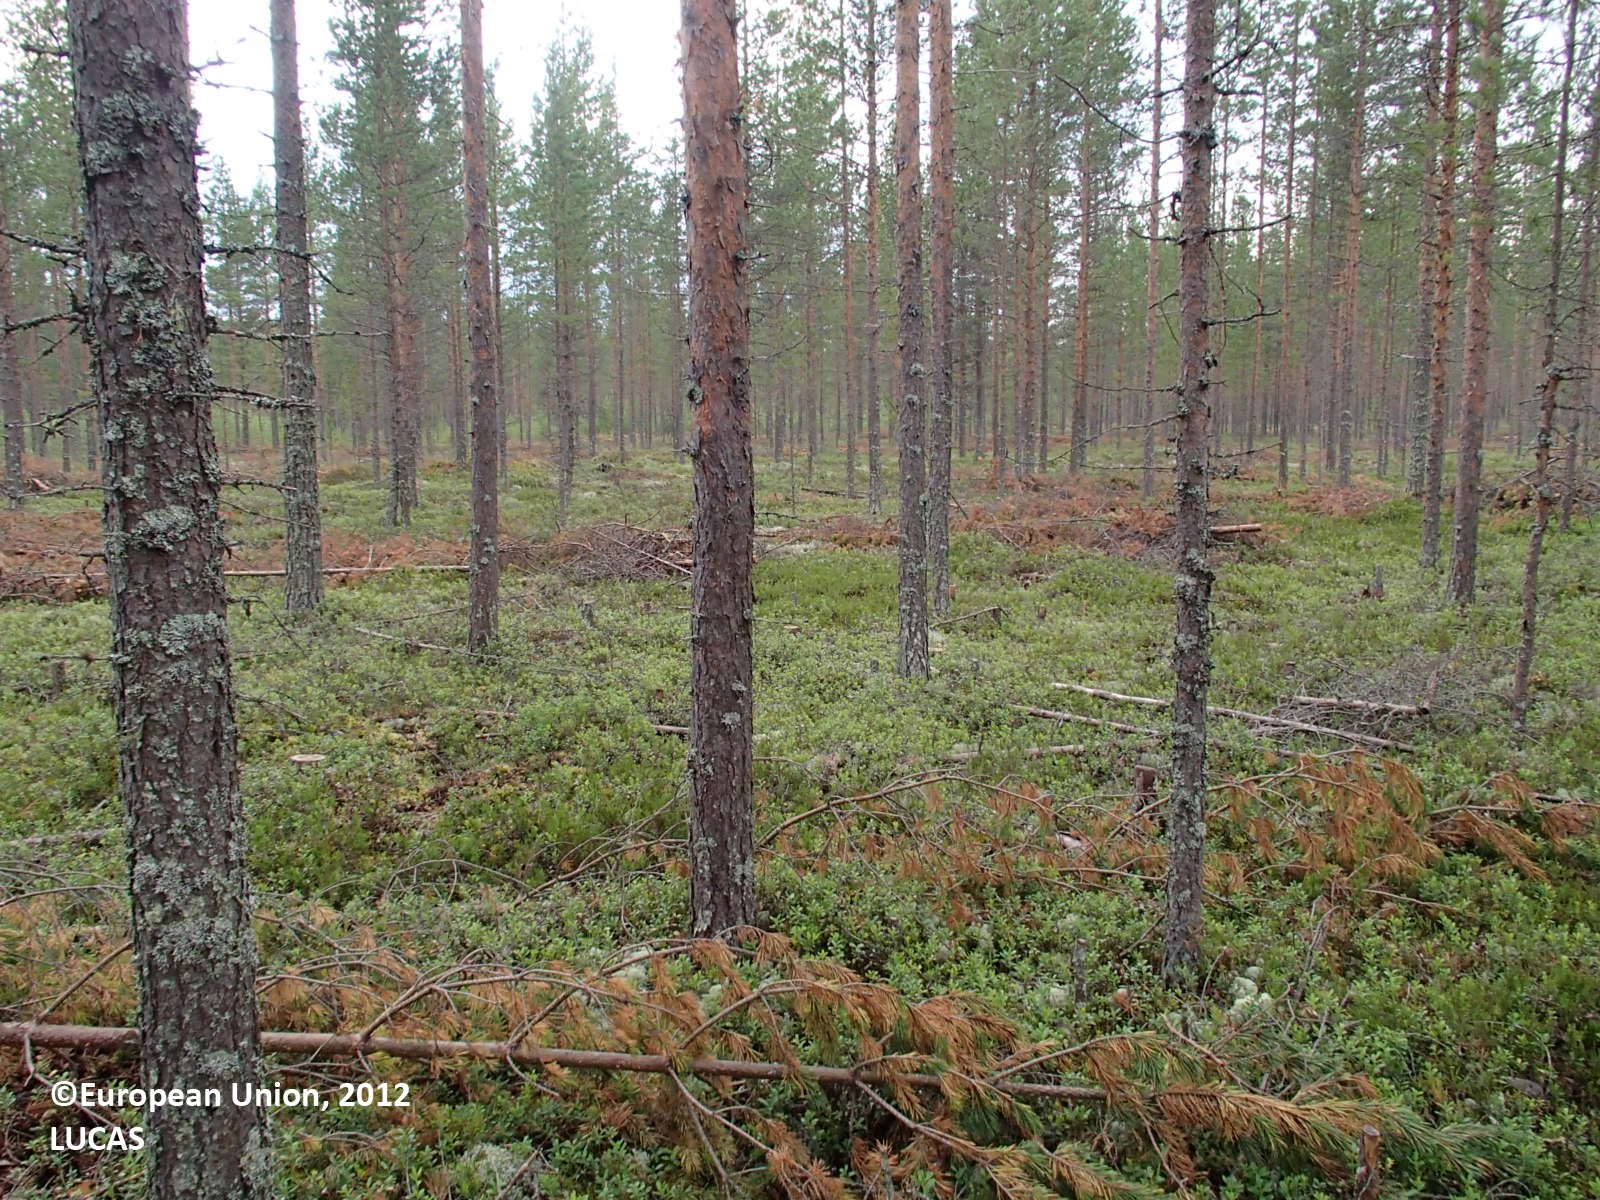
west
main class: Woodland
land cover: Pine dominated coniferous woodland
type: boreal forest
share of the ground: 50 - 75 %
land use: Forestry
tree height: > 5 m
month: July
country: FI
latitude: 64.3241
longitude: 26.3086
